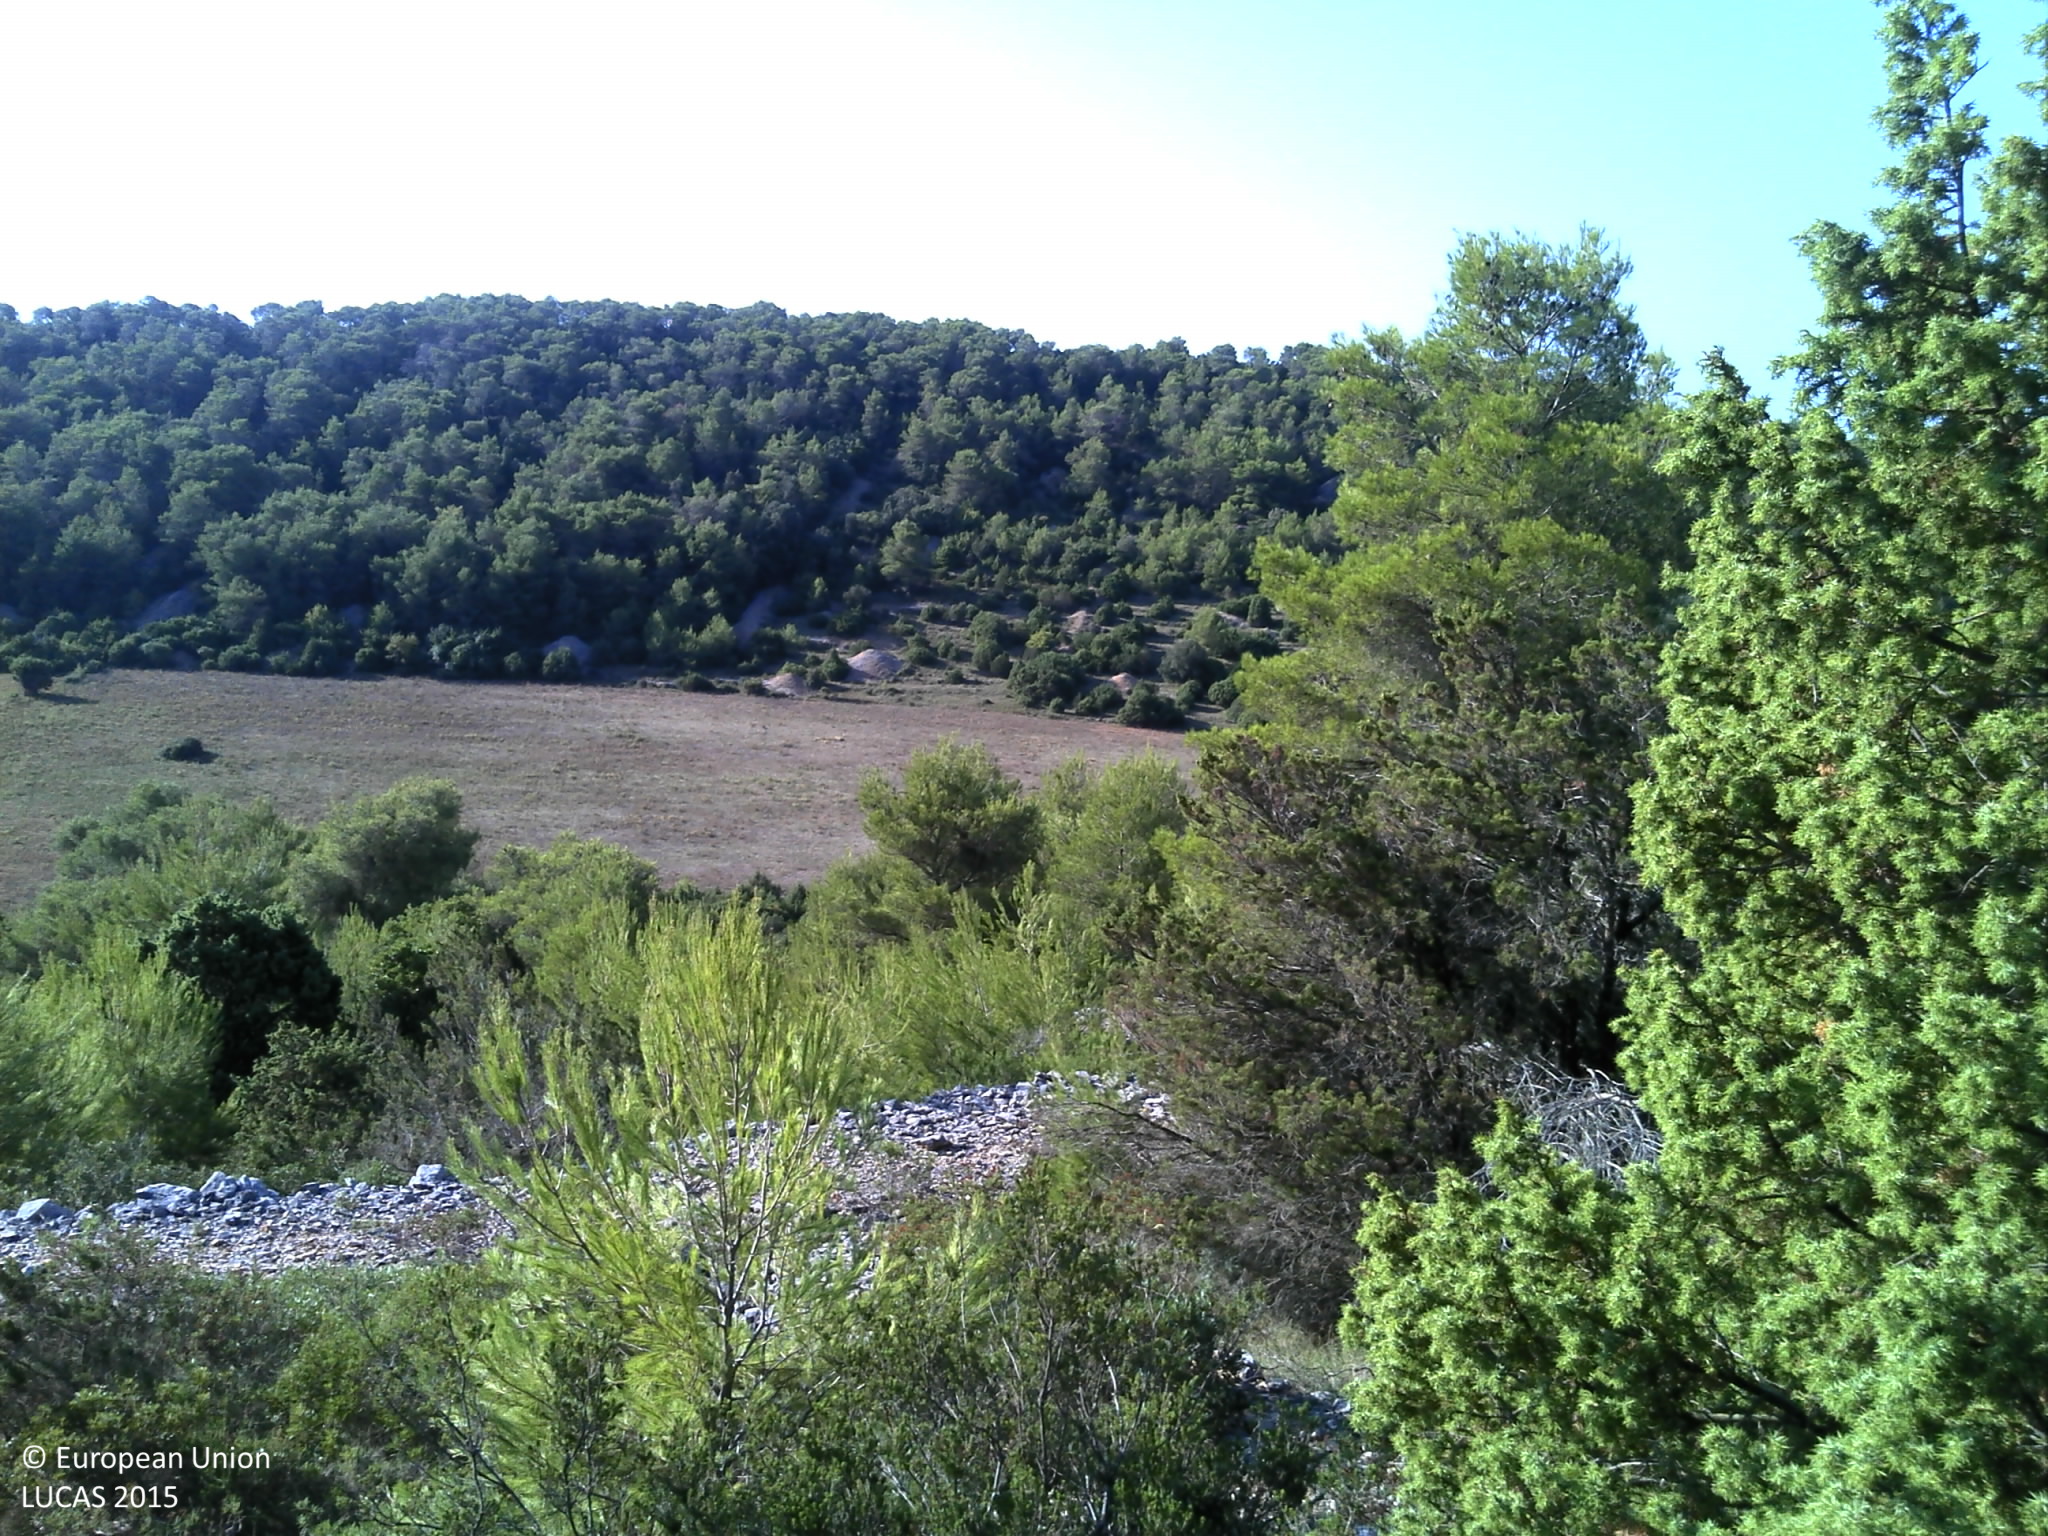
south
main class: Shrubland
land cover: Shrubland with sparse tree cover
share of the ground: > 75 %
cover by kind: shrubs 60 %, unconsolidated bare surface 20 %, herbaceous plants 10 %, coniferous forest trees 5 %, consolidated bare surface 5 %
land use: Abandoned areas
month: August
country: HR
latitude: 43.0456
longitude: 16.1633
